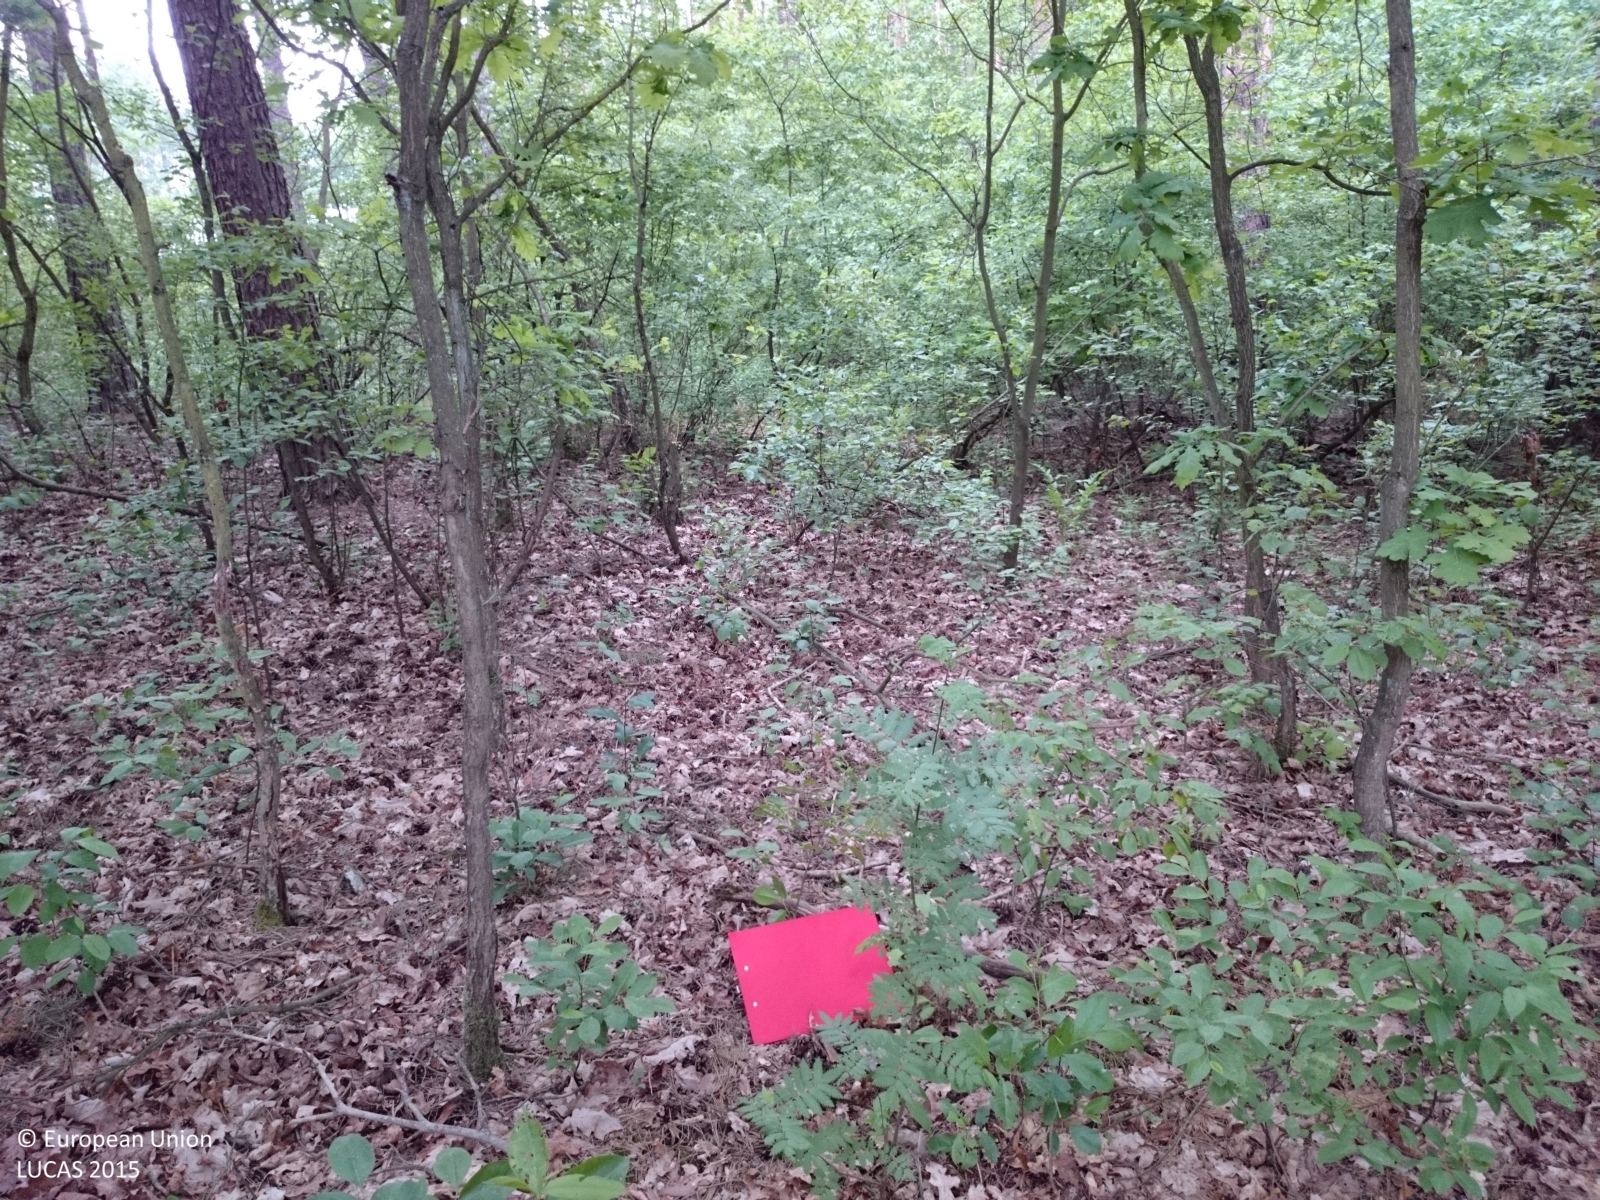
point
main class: Woodland
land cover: Pine dominated mixed woodland
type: hemiboreal forest and nemoral coniferous forest and mixed broadleaved-coniferous forest
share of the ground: > 75 %
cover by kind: coniferous forest trees 75 %, broadleaved forest trees 25 %
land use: Forestry
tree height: > 5 m
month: May
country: PL
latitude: 52.6029
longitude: 15.6595
